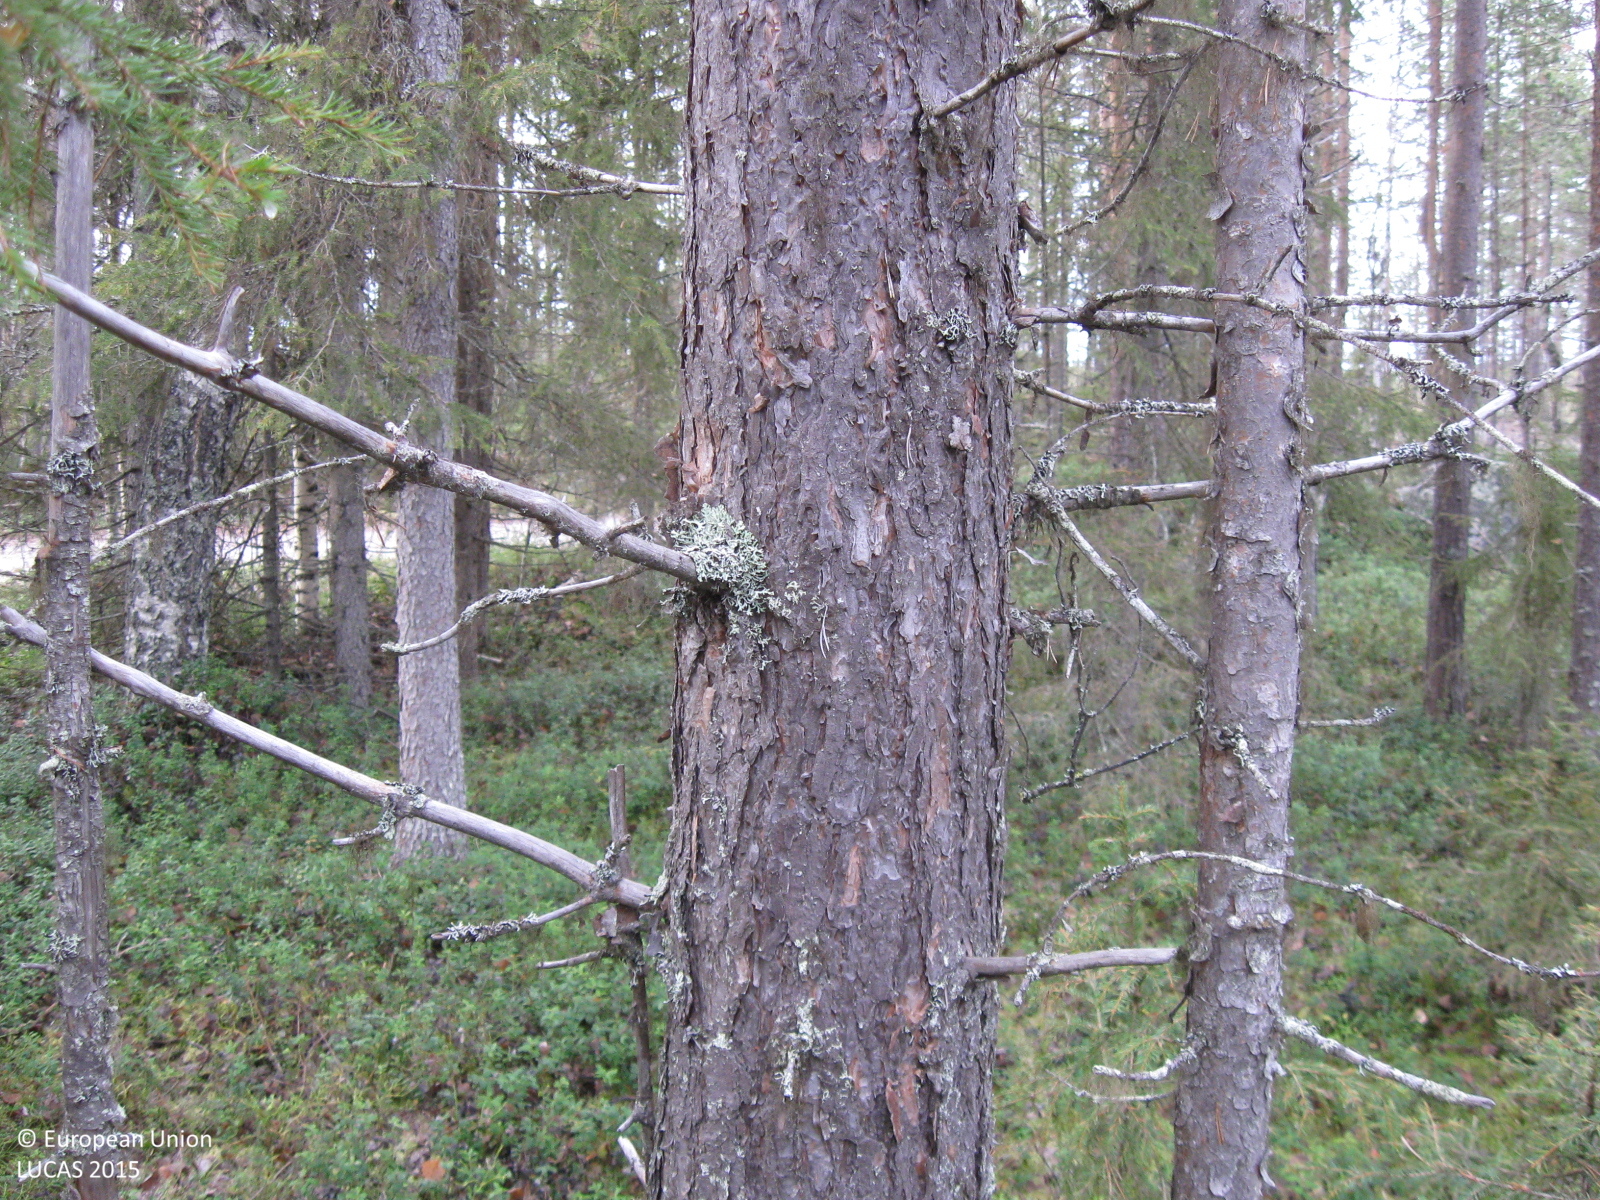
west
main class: Woodland
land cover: Other mixed woodland
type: boreal forest
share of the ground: > 75 %
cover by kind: coniferous forest trees 60 %, broadleaved forest trees 25 %, shrubs 5 %, herbaceous plants 5 %, lichens and mosses 5 %
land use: Forestry
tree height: > 5 m
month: October
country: SE
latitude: 66.2481
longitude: 21.5132
